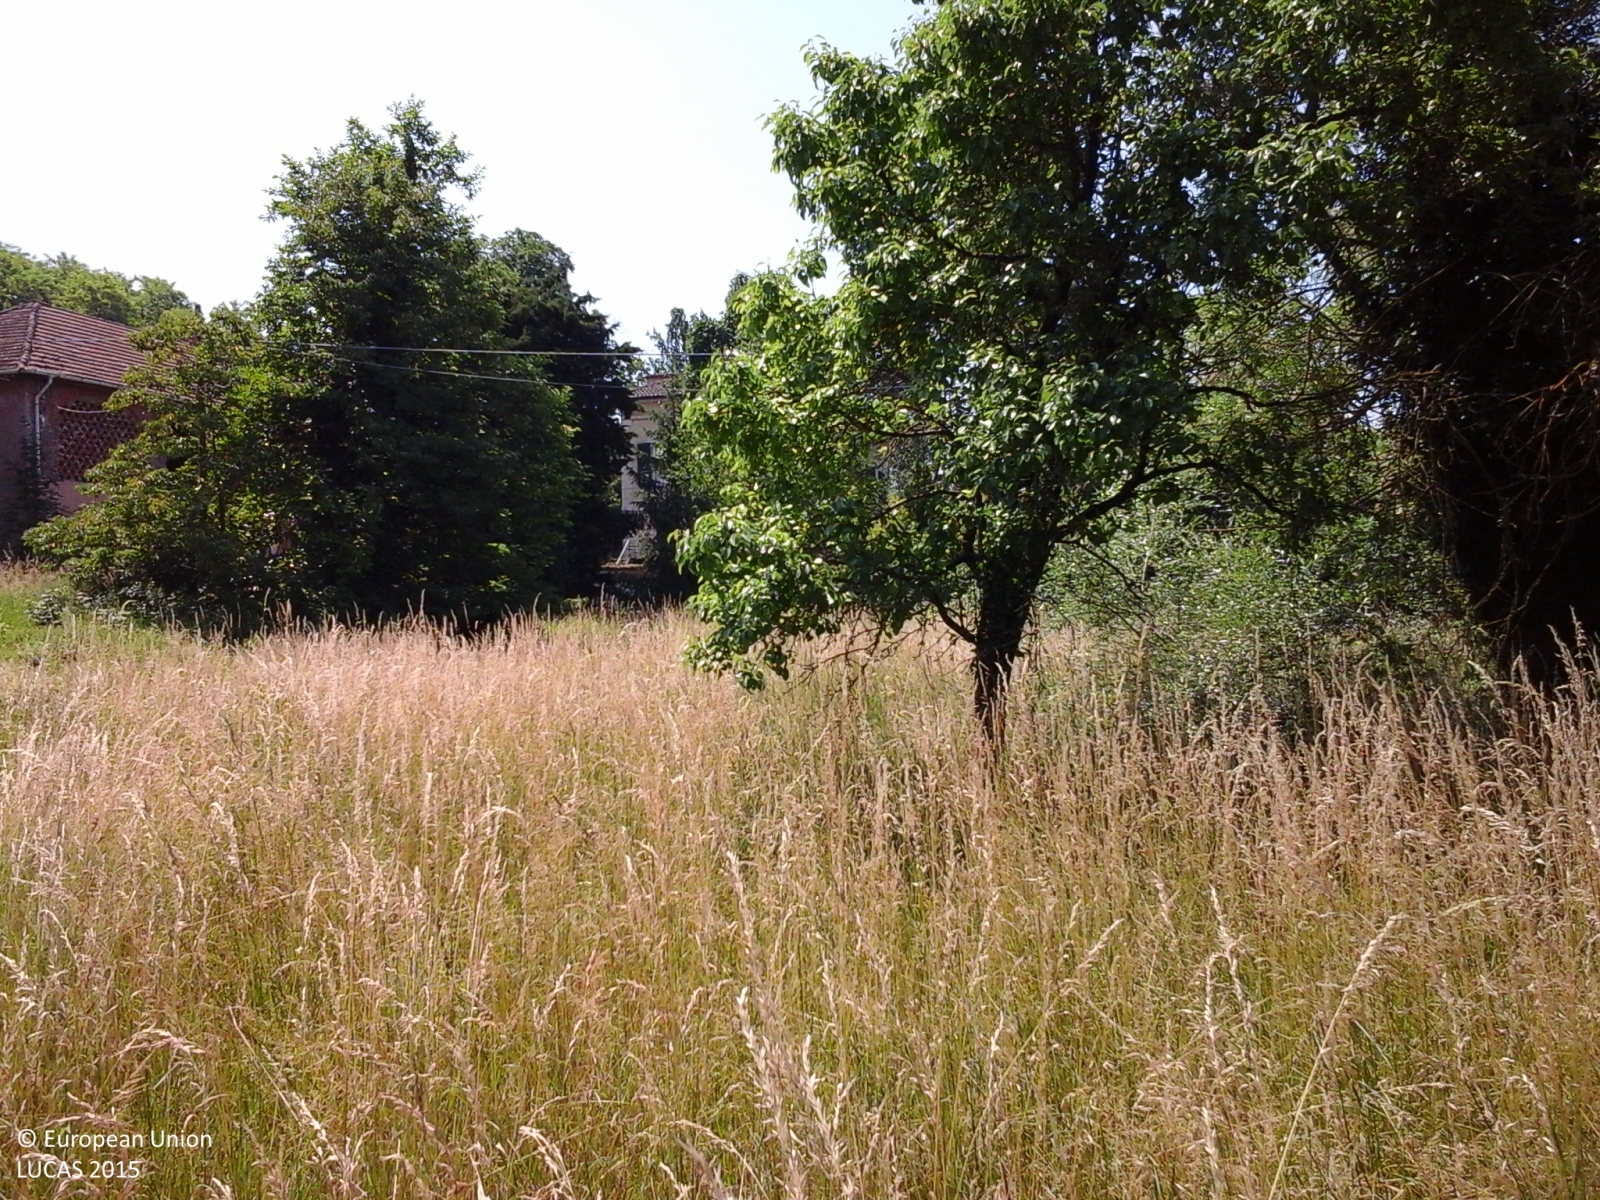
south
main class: Grassland
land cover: Grassland without tree/shrub cover
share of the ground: > 75 %
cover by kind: herbaceous plants 100 %
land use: Agriculture (excluding fallow land and kitchen gardens)
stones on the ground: 10 - 25 %
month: June
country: IT
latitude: 44.6484
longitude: 8.6537
